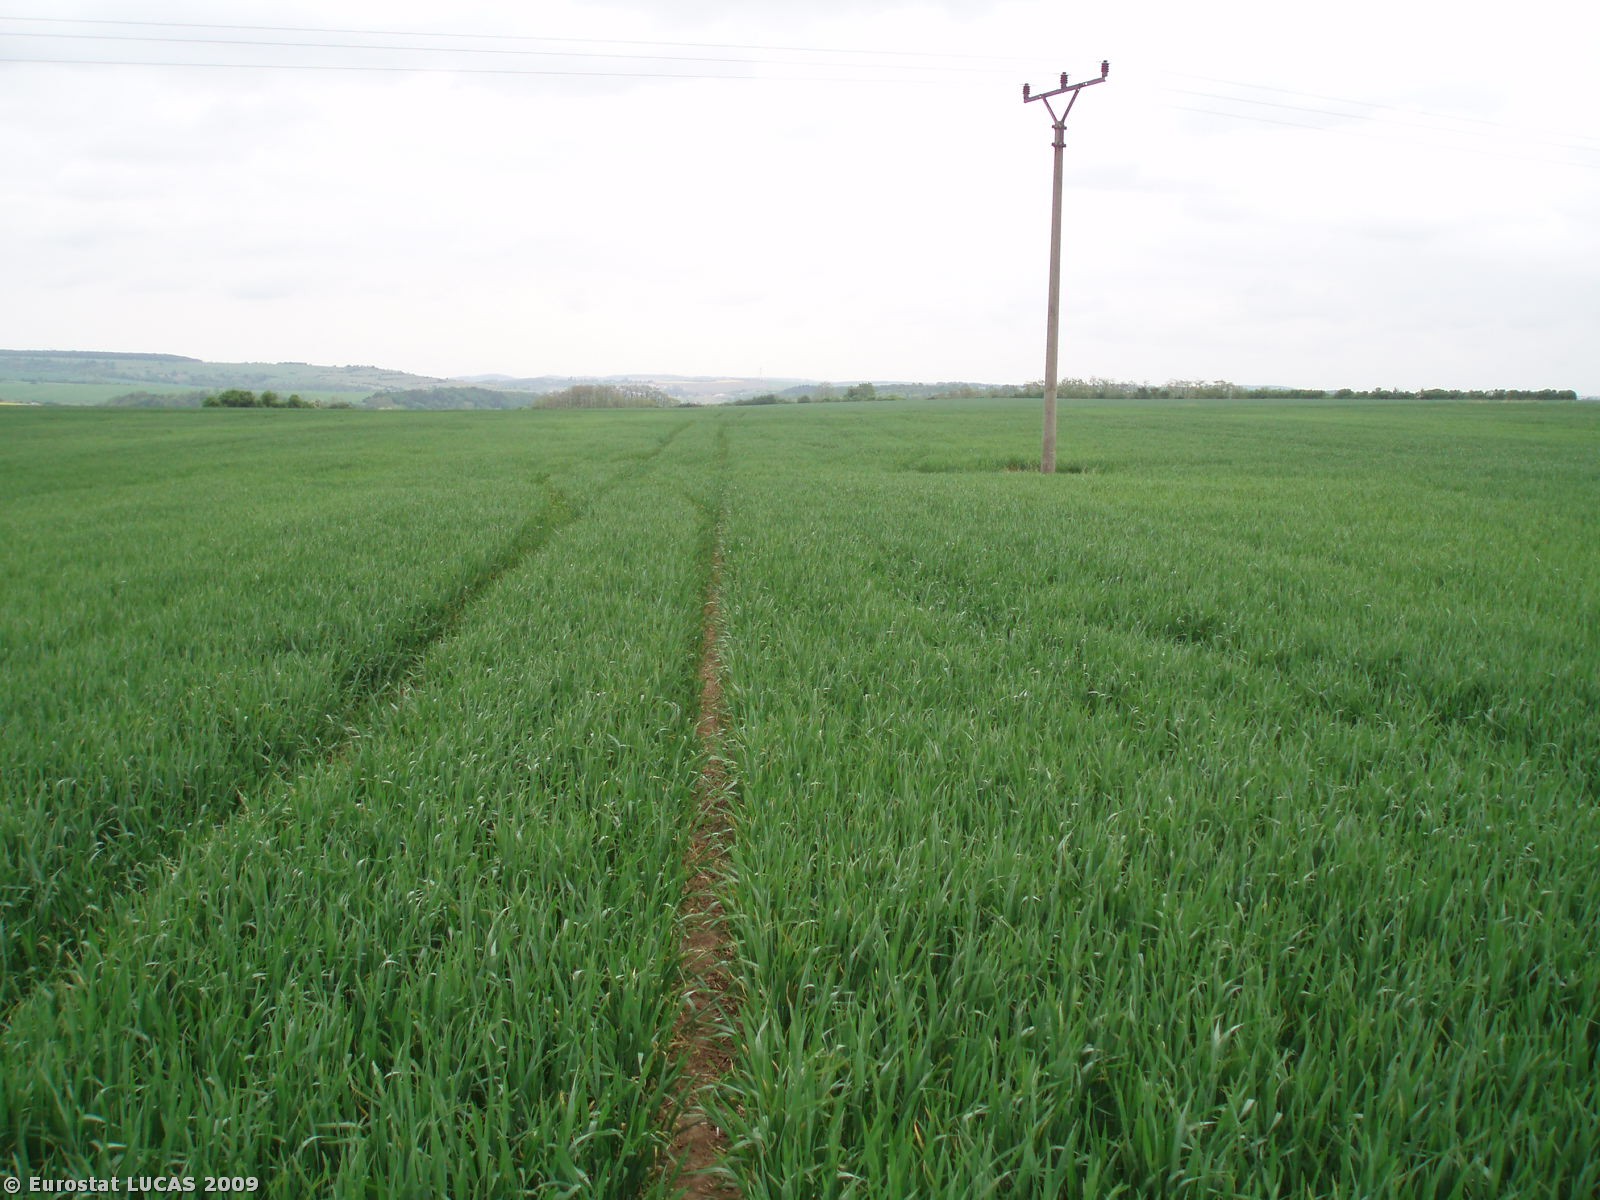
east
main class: Cropland
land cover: Common wheat
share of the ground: > 75 %
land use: Agriculture (excluding fallow land and kitchen gardens)
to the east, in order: Common wheat; Electric lines; Common wheat; Grass margins; Common wheat
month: May
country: CZ
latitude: 50.2322
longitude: 14.2210
